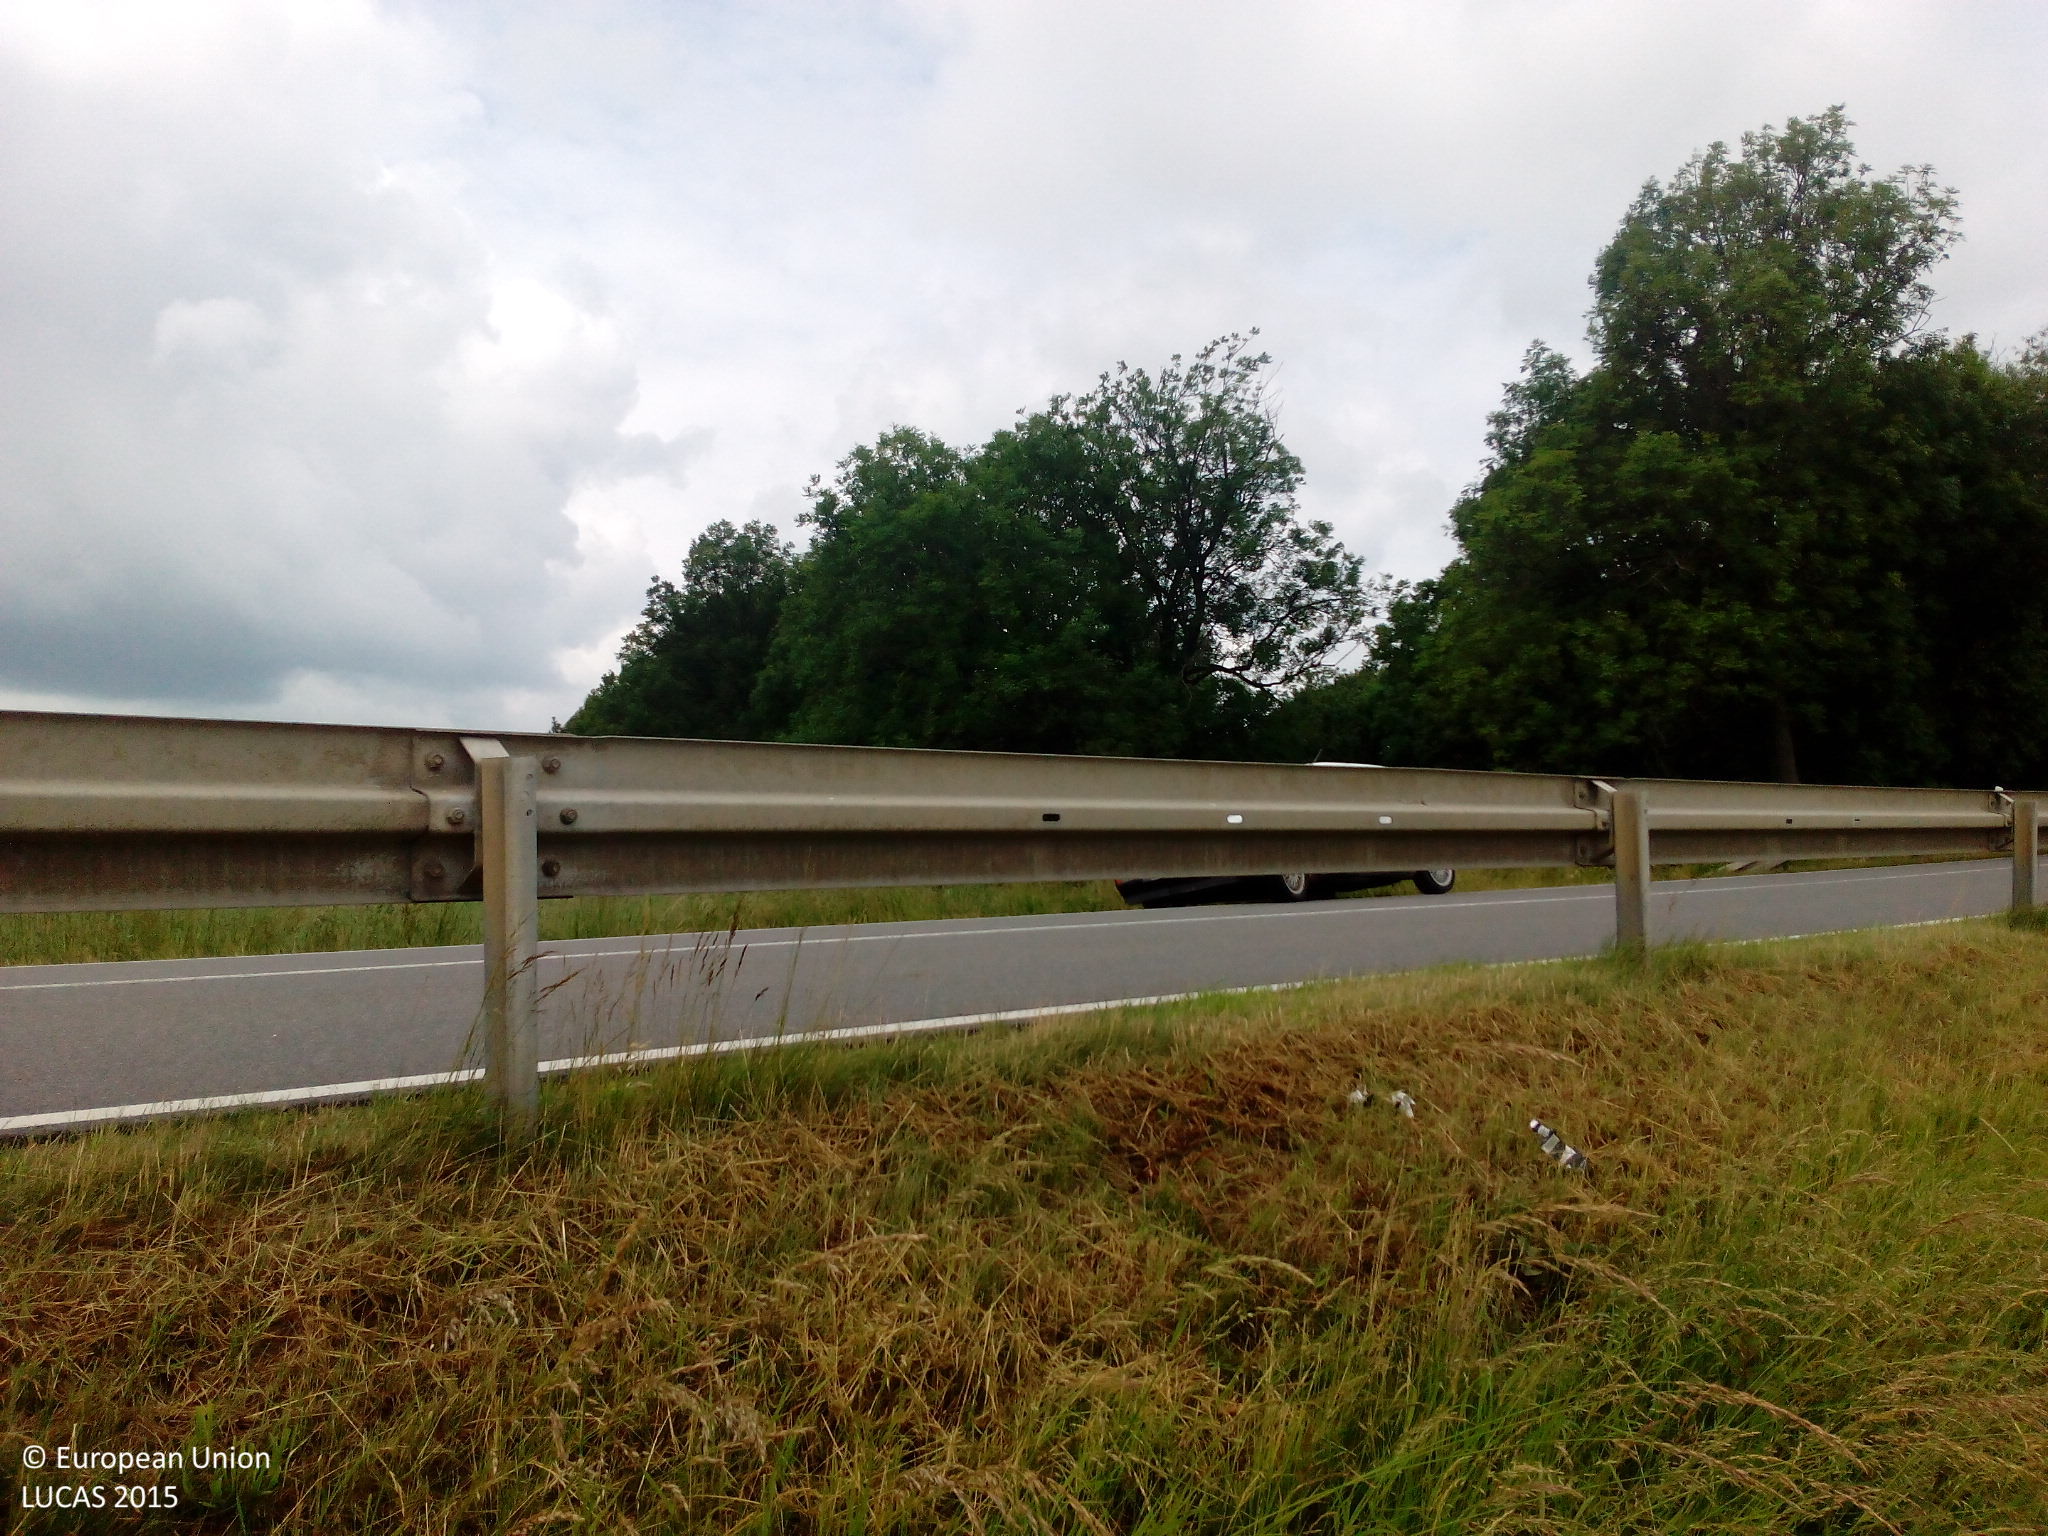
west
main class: Cropland
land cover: Common wheat
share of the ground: > 75 %
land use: Agriculture (excluding fallow land and kitchen gardens)
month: June
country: DE
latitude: 51.0419
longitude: 13.0951
